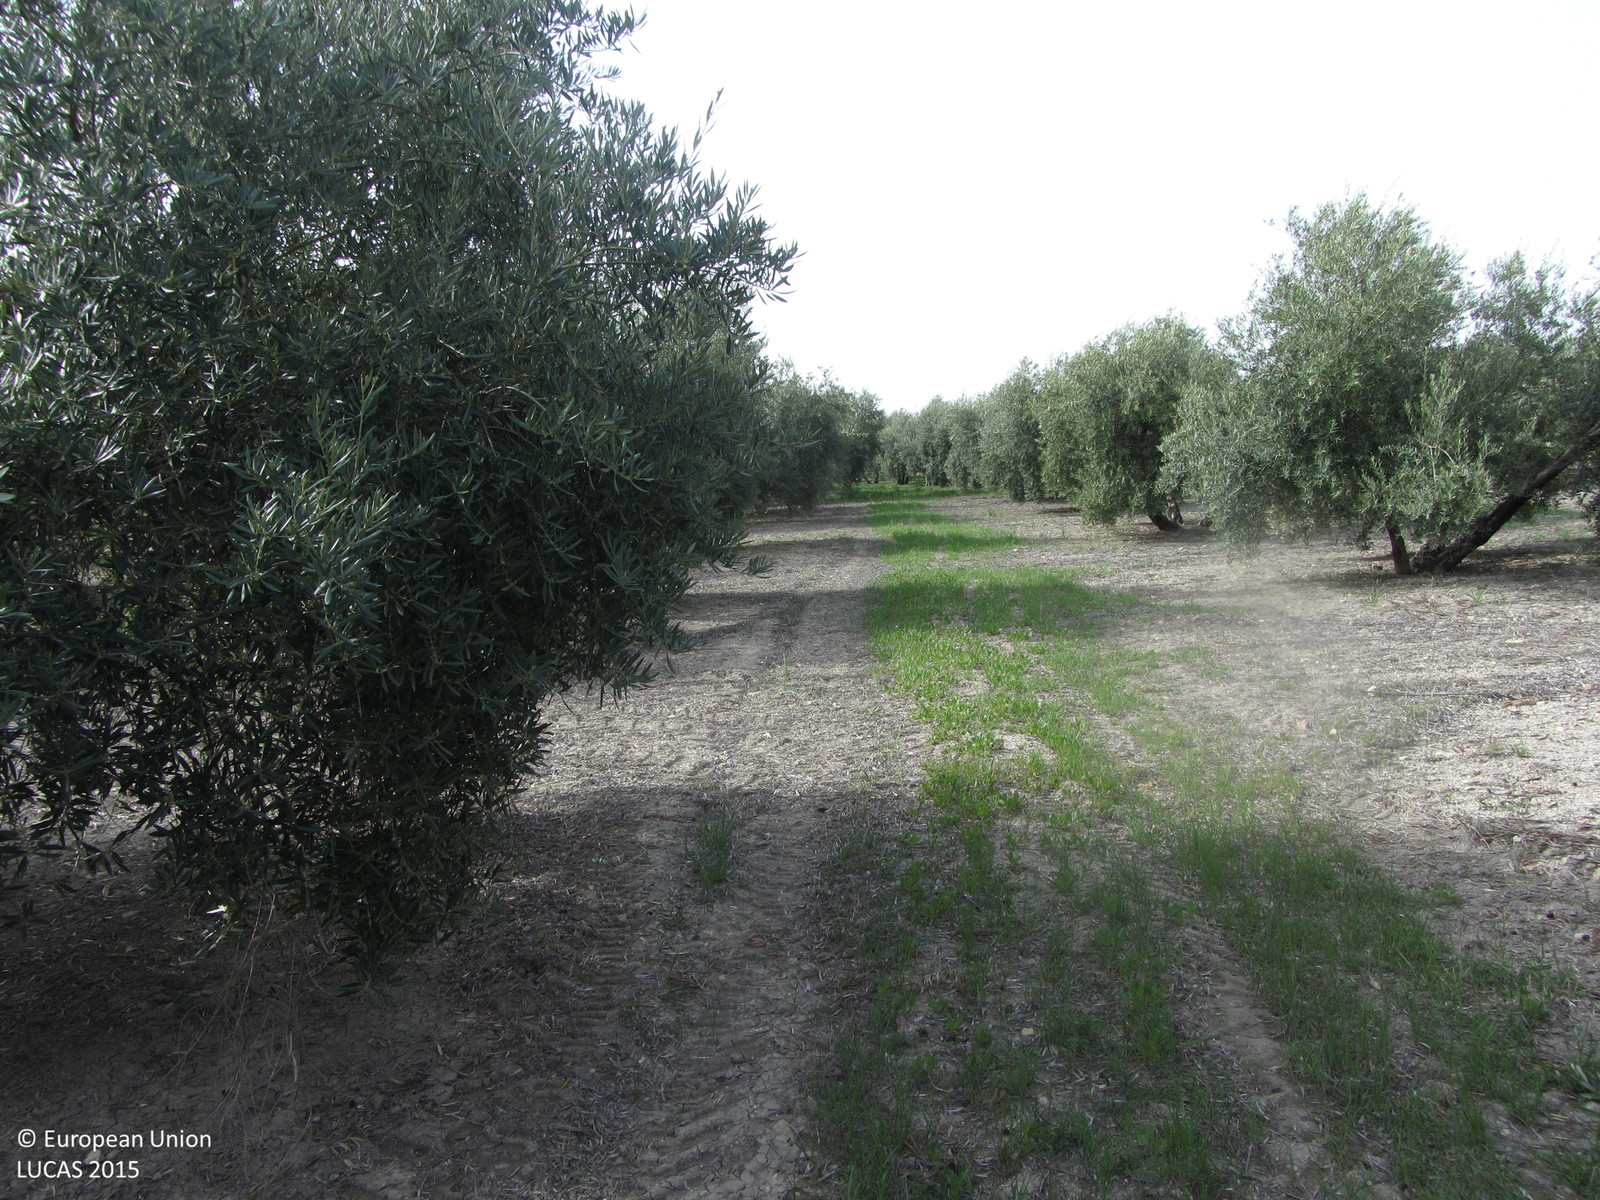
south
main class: Cropland
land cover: Olive groves
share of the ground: 50 - 75 %
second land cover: Spontaneously vegetated surfaces
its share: 10 - 25 %
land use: Agriculture (excluding fallow land and kitchen gardens)
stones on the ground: < 10 %
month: April
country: ES
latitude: 38.1054
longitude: -3.0794
